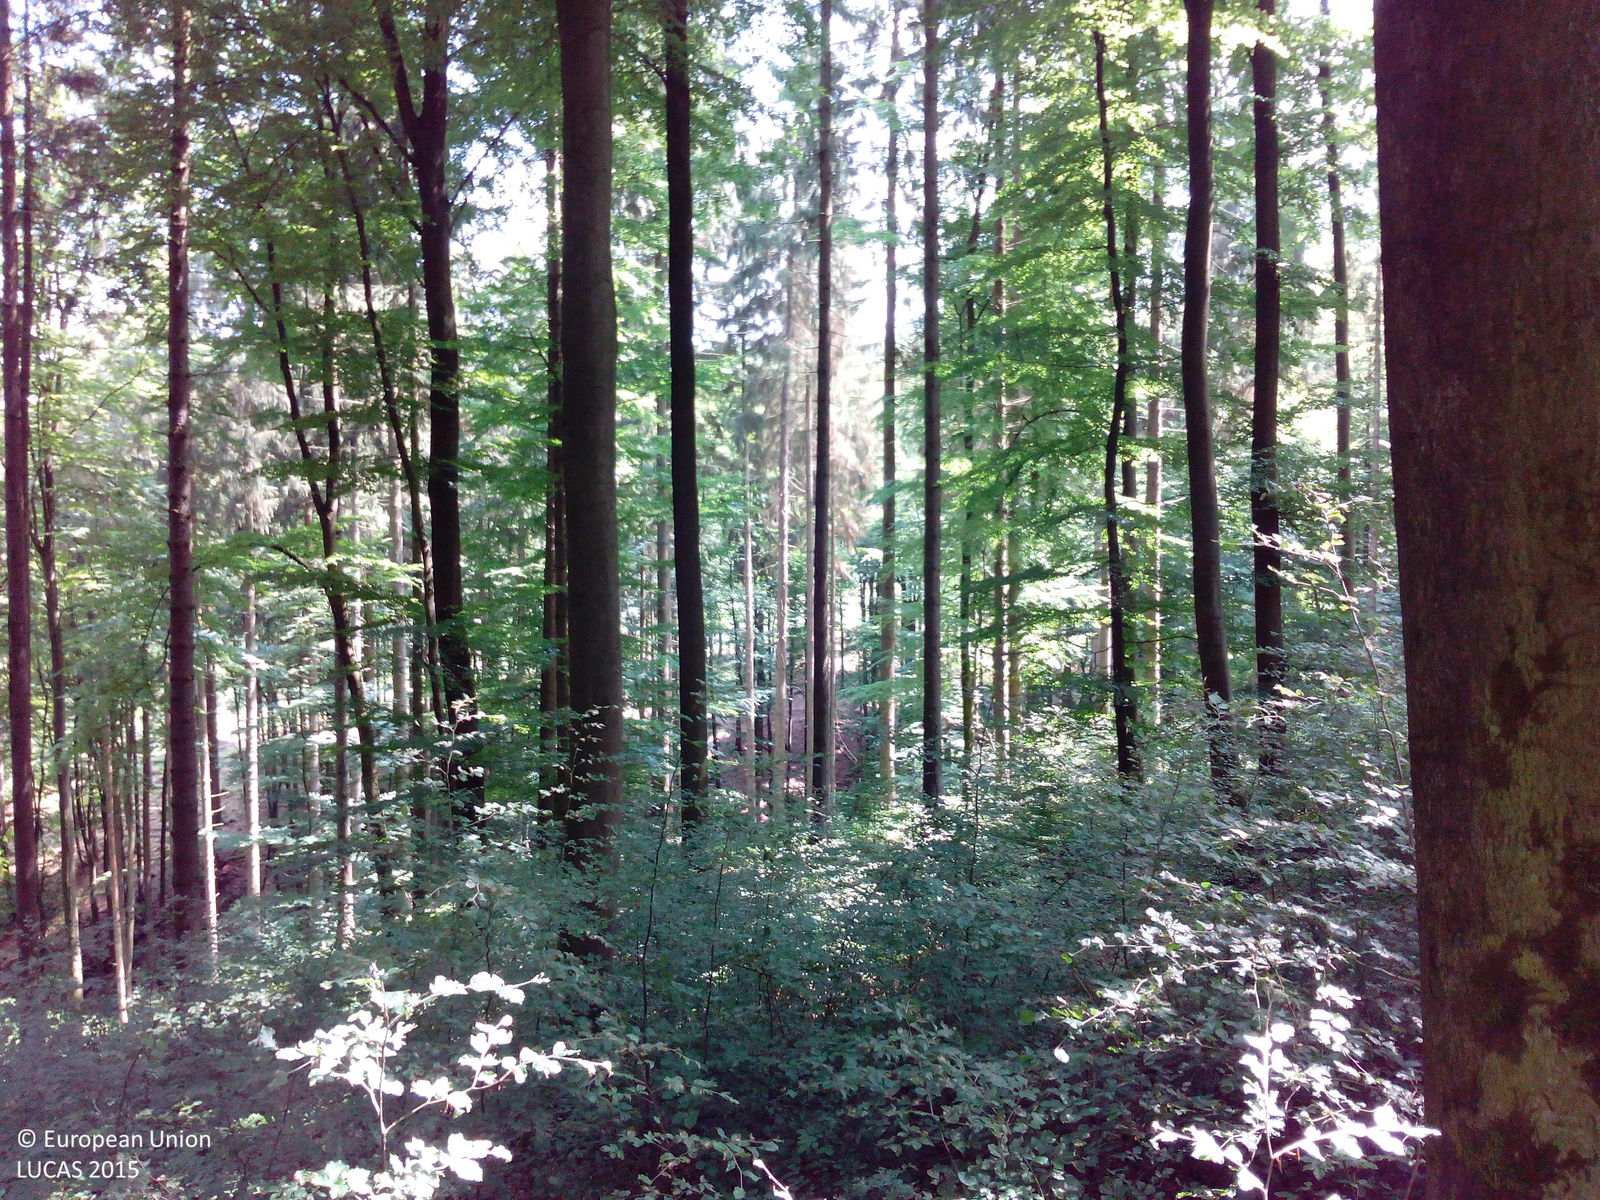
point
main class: Woodland
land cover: Spruce dominated mixed woodland
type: hemiboreal forest and nemoral coniferous forest and mixed broadleaved-coniferous forest
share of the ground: > 75 %
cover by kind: coniferous forest trees 75 %, broadleaved forest trees 25 %
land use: Forestry
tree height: > 5 m
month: July
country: DE
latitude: 51.9281
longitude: 9.9273
